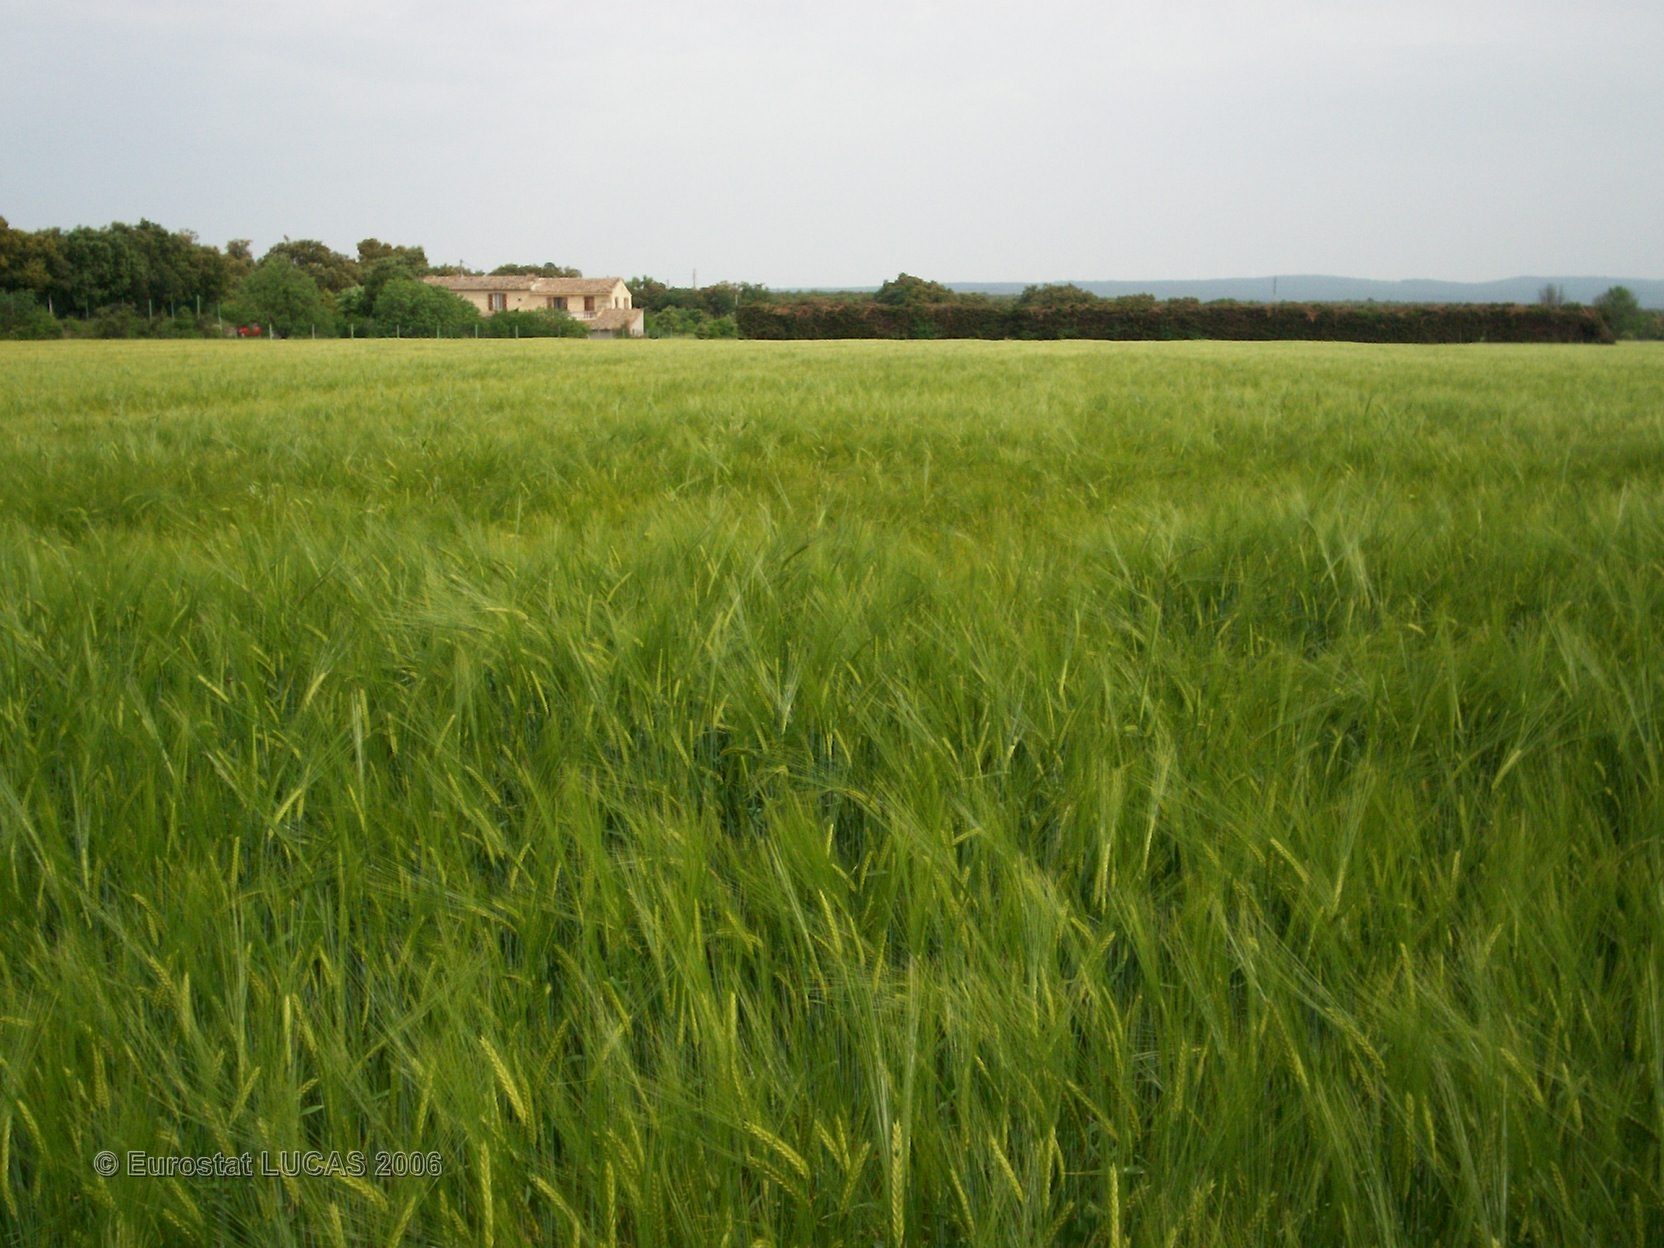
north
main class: Cropland
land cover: Barley
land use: Agriculture (excluding fallow land and kitchen gardens)
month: May
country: FR
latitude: 44.4045
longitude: 4.8716
